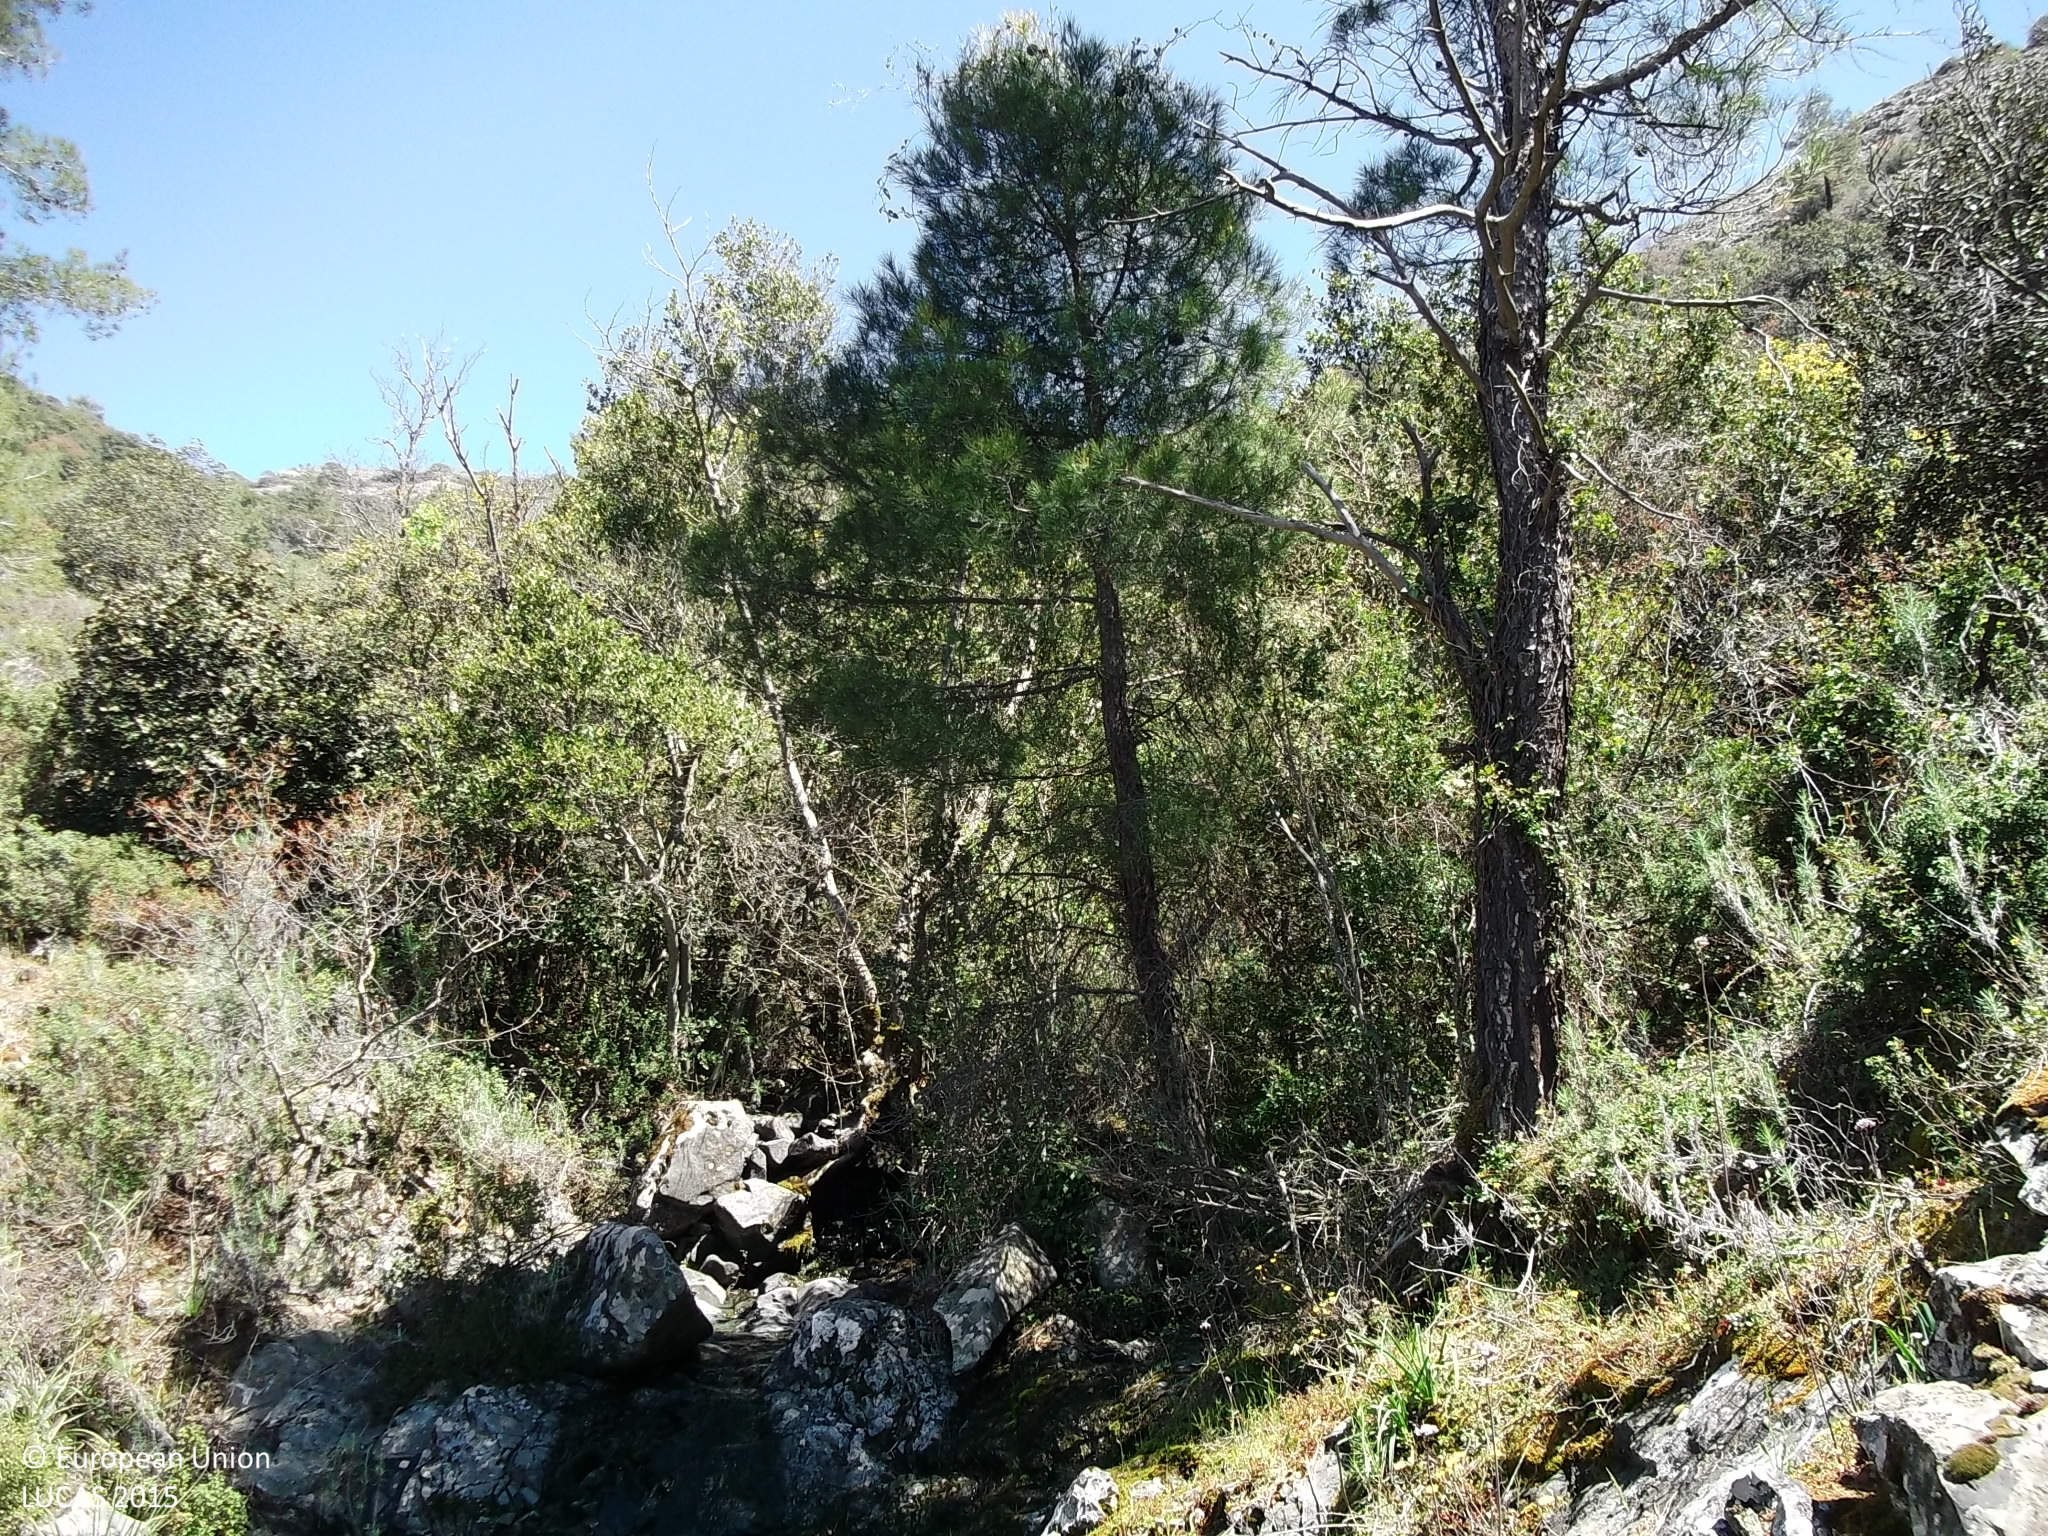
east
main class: Shrubland
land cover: Shrubland with sparse tree cover
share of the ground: > 75 %
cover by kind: shrubs 75 %, consolidated bare surface 10 %, unconsolidated bare surface 10 %, coniferous forest trees 5 %
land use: Semi-natural and natural areas not in use
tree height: > 5 m
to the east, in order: Shrubland with sparse tree cover
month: April
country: CY
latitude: 34.9178
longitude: 33.1752
